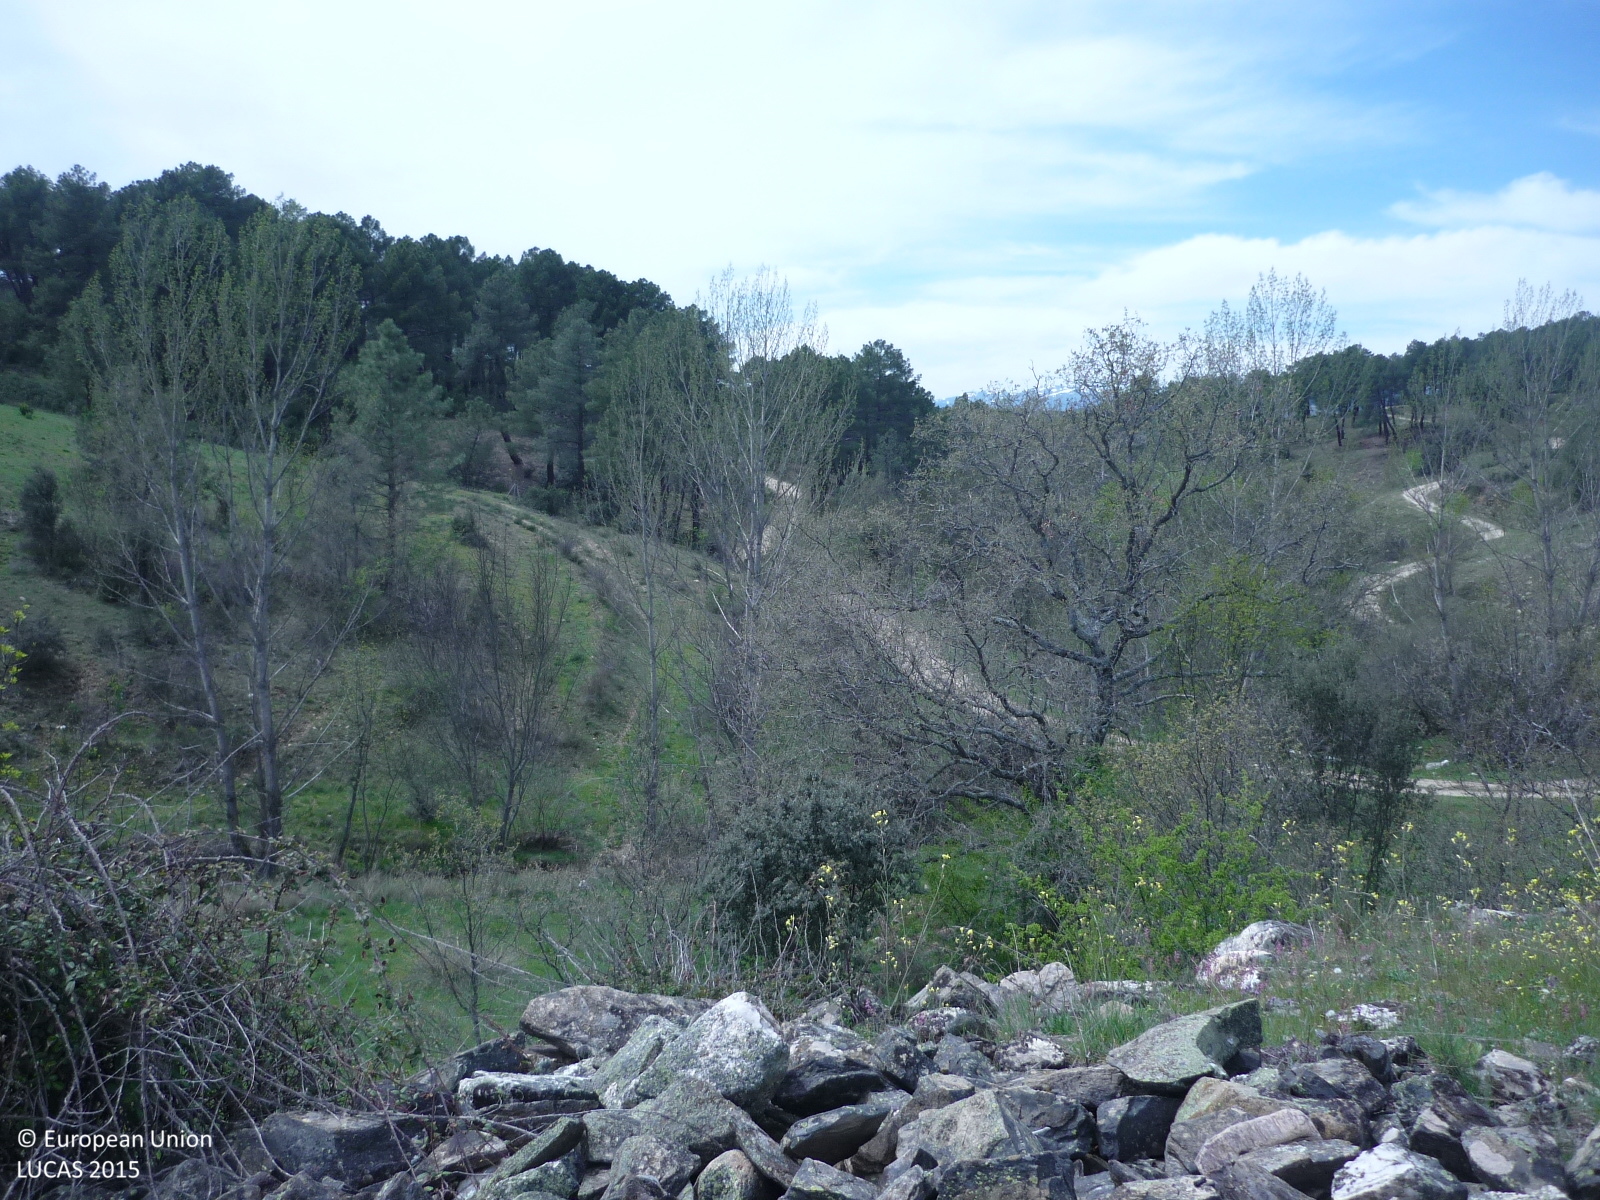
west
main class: Shrubland
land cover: Shrubland without tree cover
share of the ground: 50 - 75 %
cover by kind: shrubs 60 %, herbaceous plants 30 %, unconsolidated bare surface 10 %
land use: Semi-natural and natural areas not in use
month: April
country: ES
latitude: 40.9522
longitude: -3.5497
